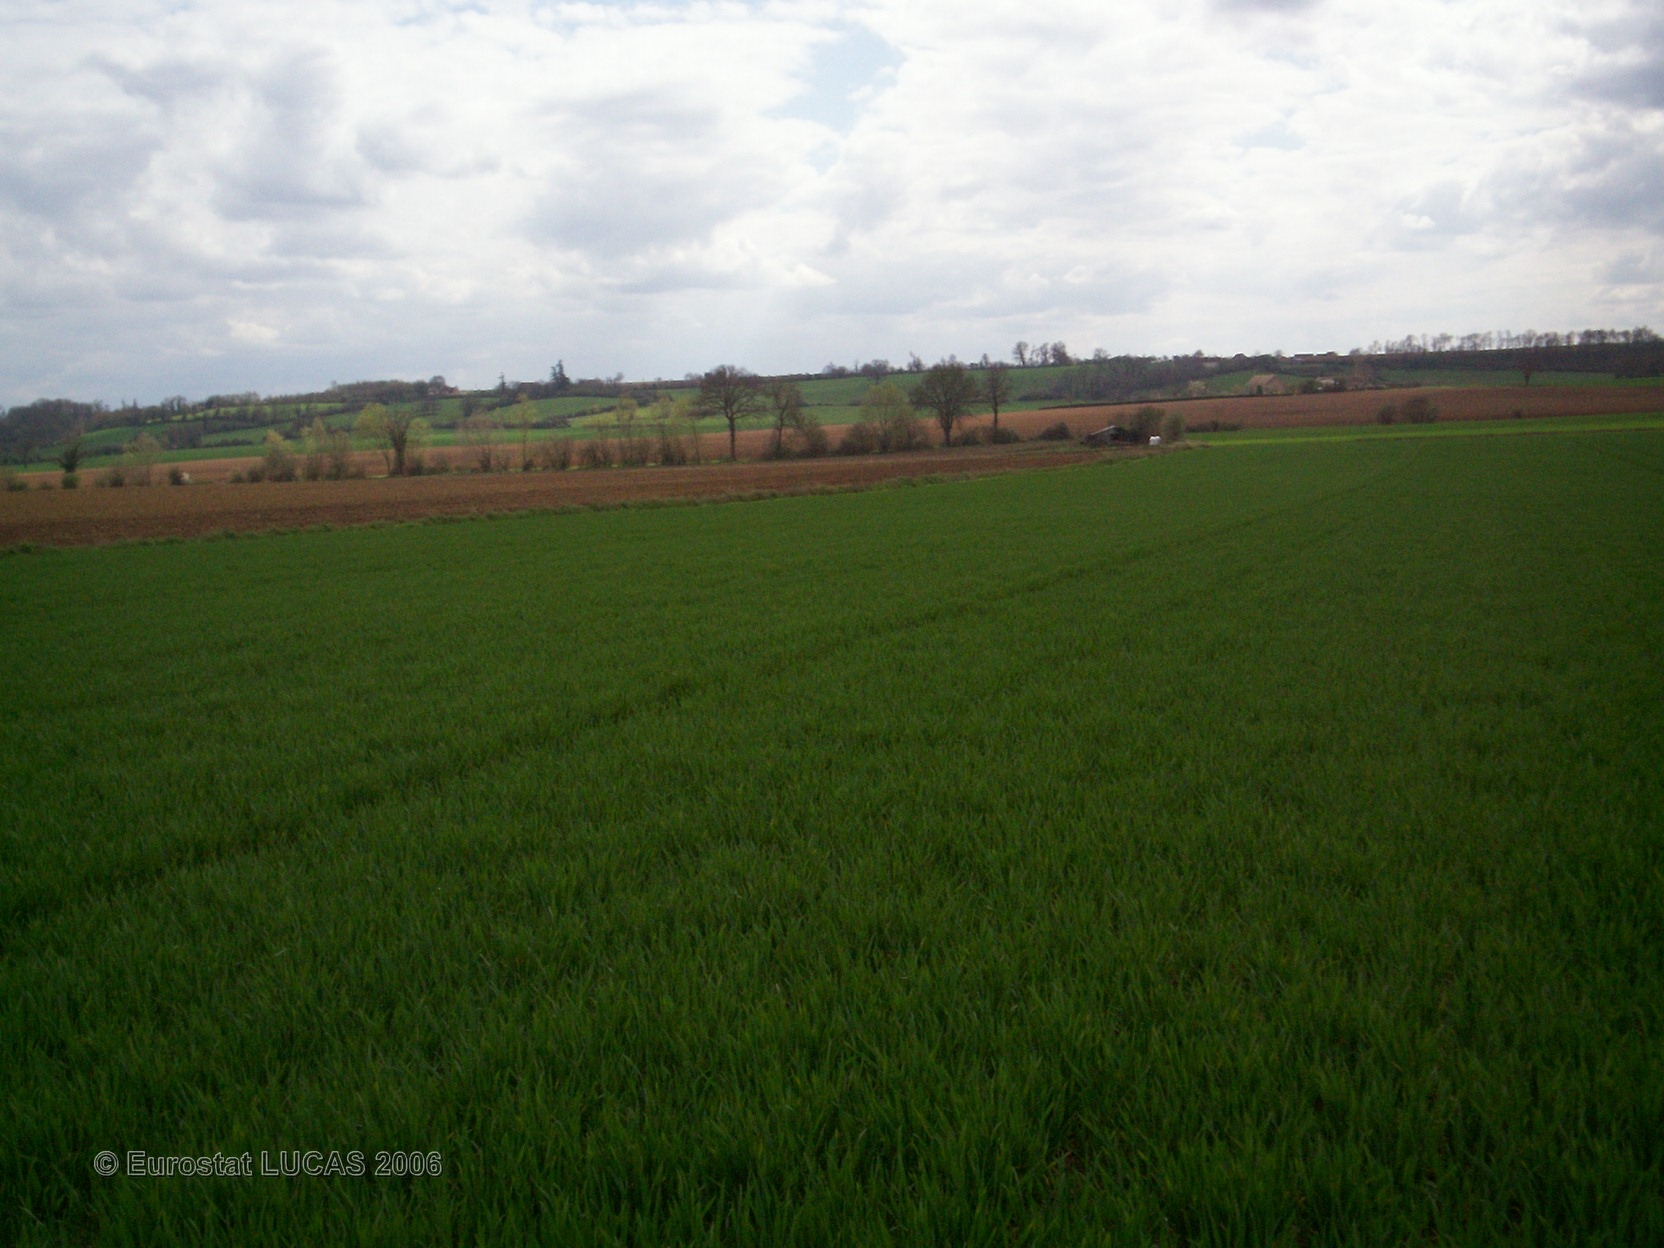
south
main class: Cropland
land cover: Common wheat
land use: Agriculture (excluding fallow land and kitchen gardens)
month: April
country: FR
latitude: 48.3053
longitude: 0.3345
